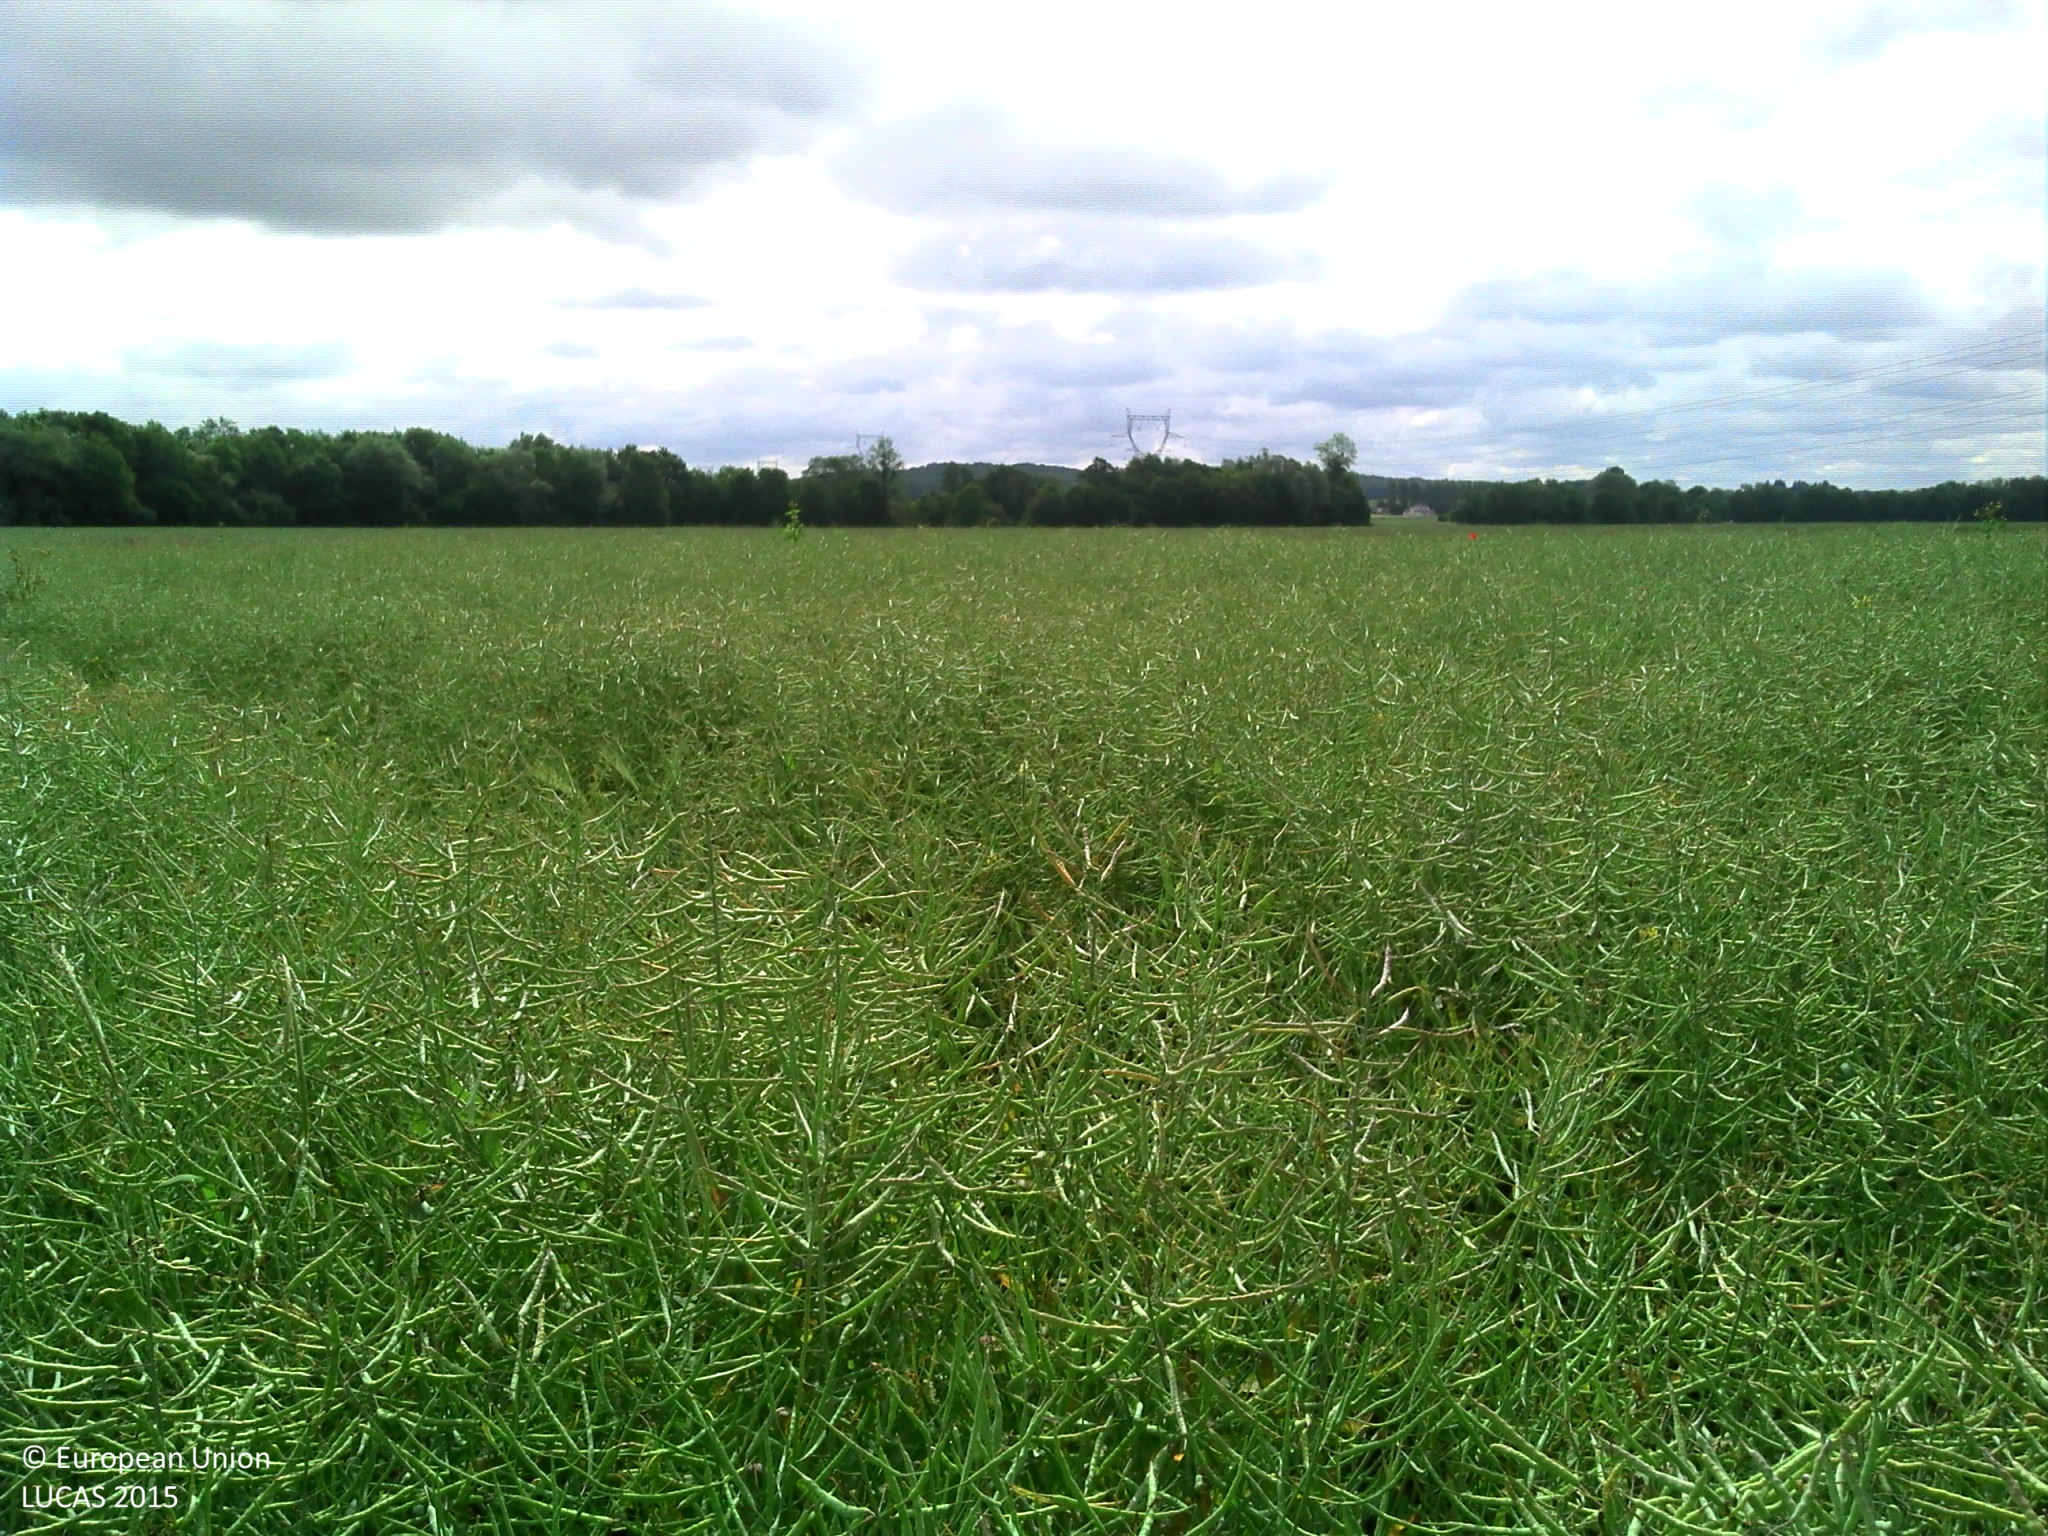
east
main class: Cropland
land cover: Rape and turnip rape
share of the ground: > 75 %
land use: Agriculture (excluding fallow land and kitchen gardens)
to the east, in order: Rape and turnip rape; Common wheat; Temporary grasslands
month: June
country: FR
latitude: 48.5212
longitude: 4.9210
